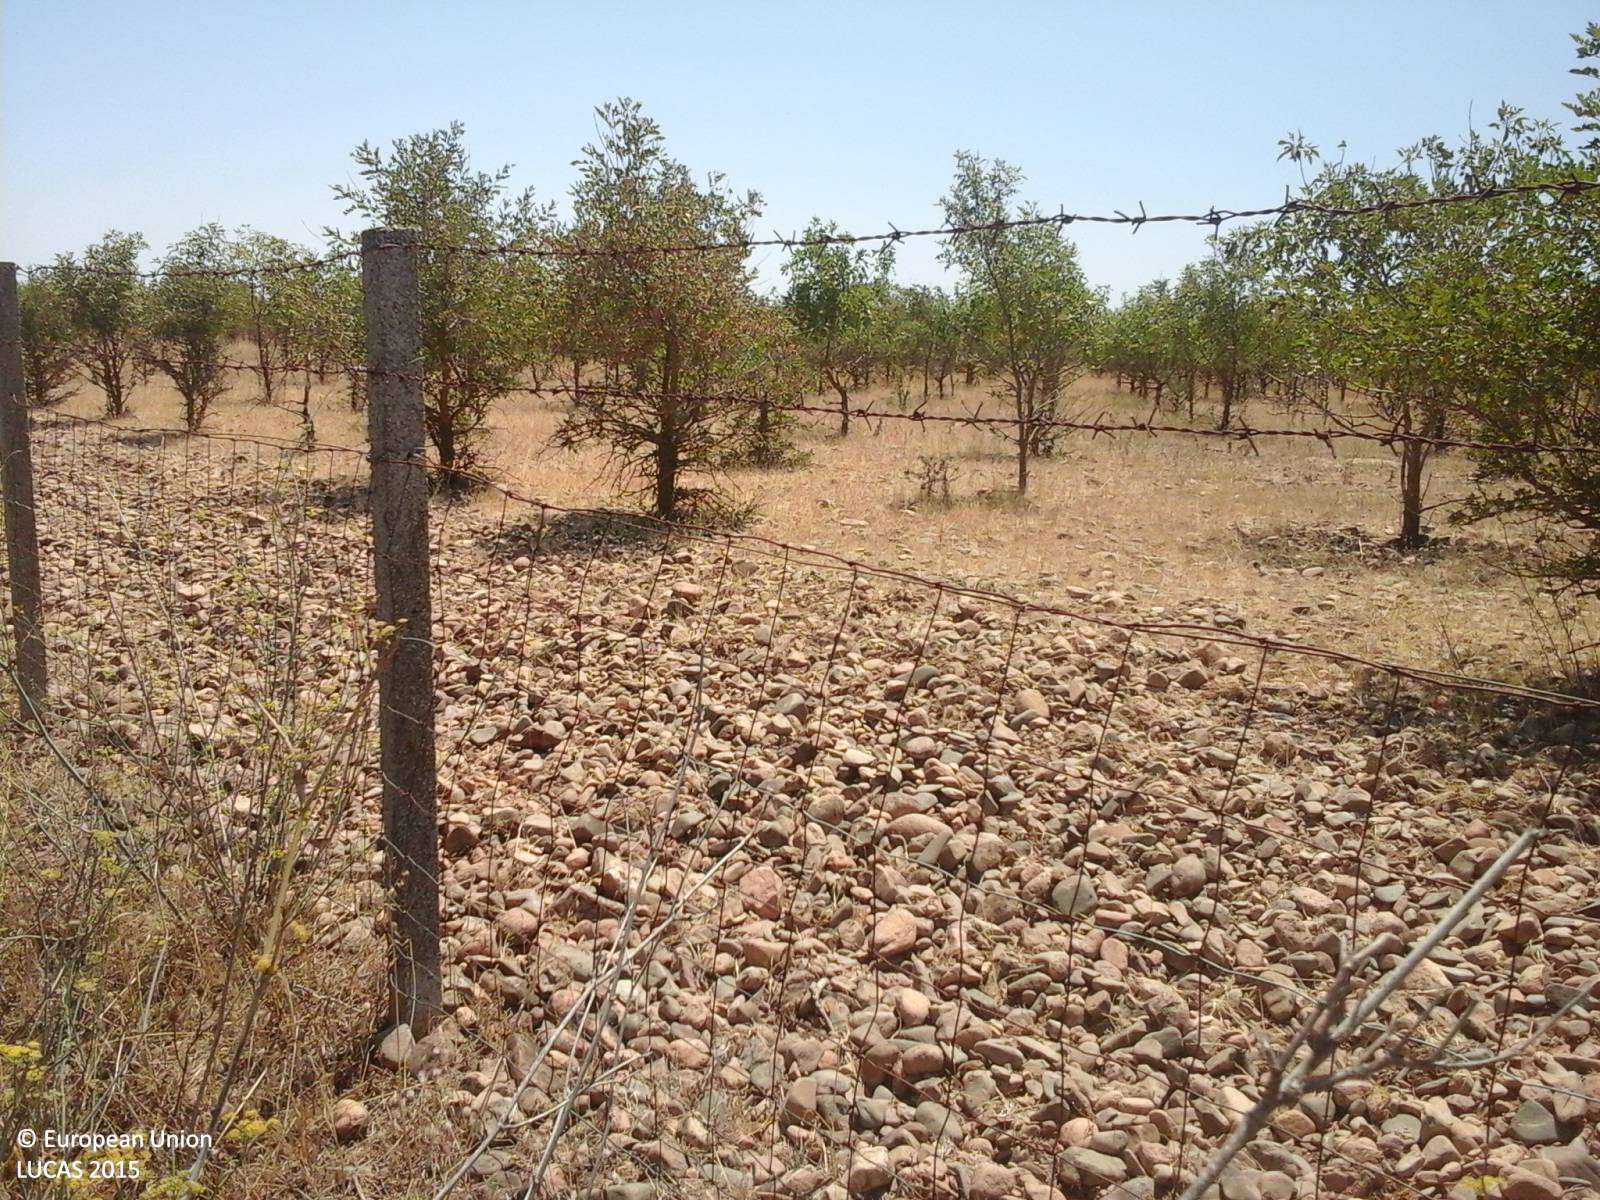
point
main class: Woodland
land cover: Broadleaved woodland
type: thermophilous deciduous forest
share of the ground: > 75 %
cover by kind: broadleaved forest trees 100 %
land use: Forestry
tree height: < 5 m
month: August
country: IT
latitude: 39.3734
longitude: 8.8808
